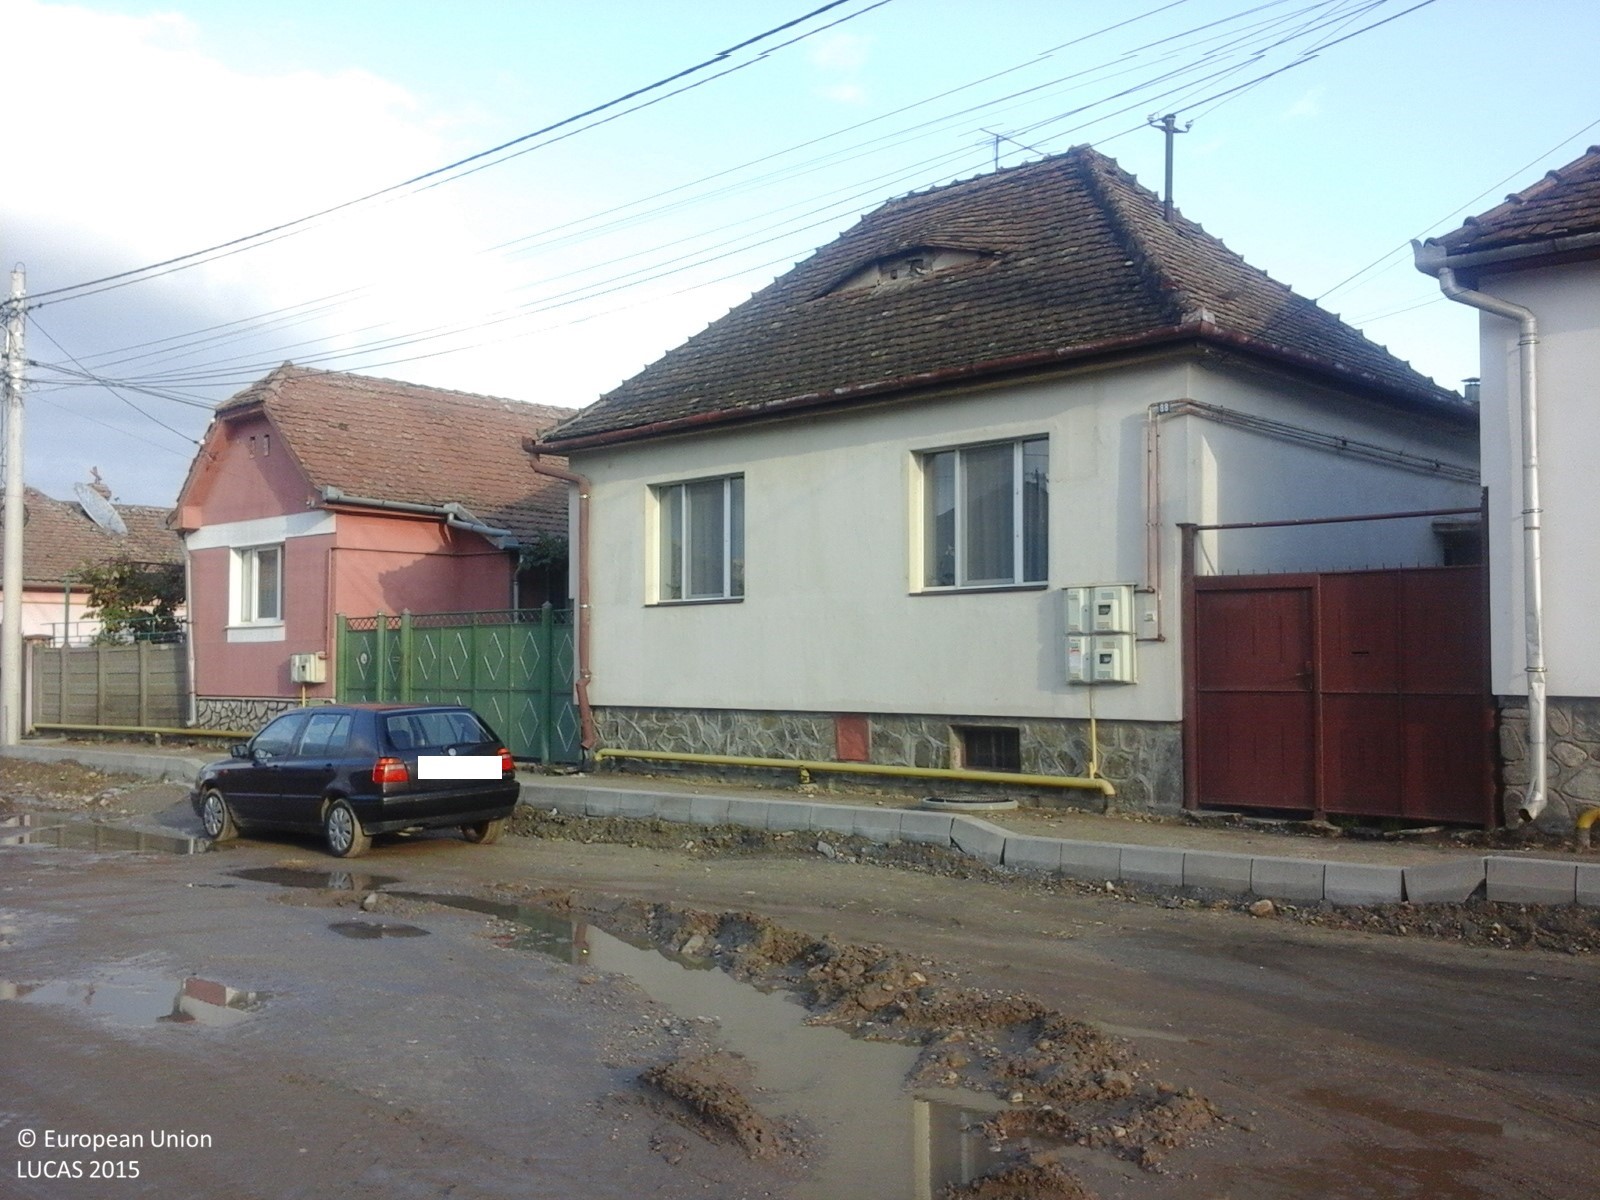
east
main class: Cropland
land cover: Vineyards
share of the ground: > 75 %
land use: Agriculture (excluding fallow land and kitchen gardens)
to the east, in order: Vineyards; Artificial constructions in urban areas
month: October
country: RO
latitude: 45.8082
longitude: 24.1395
